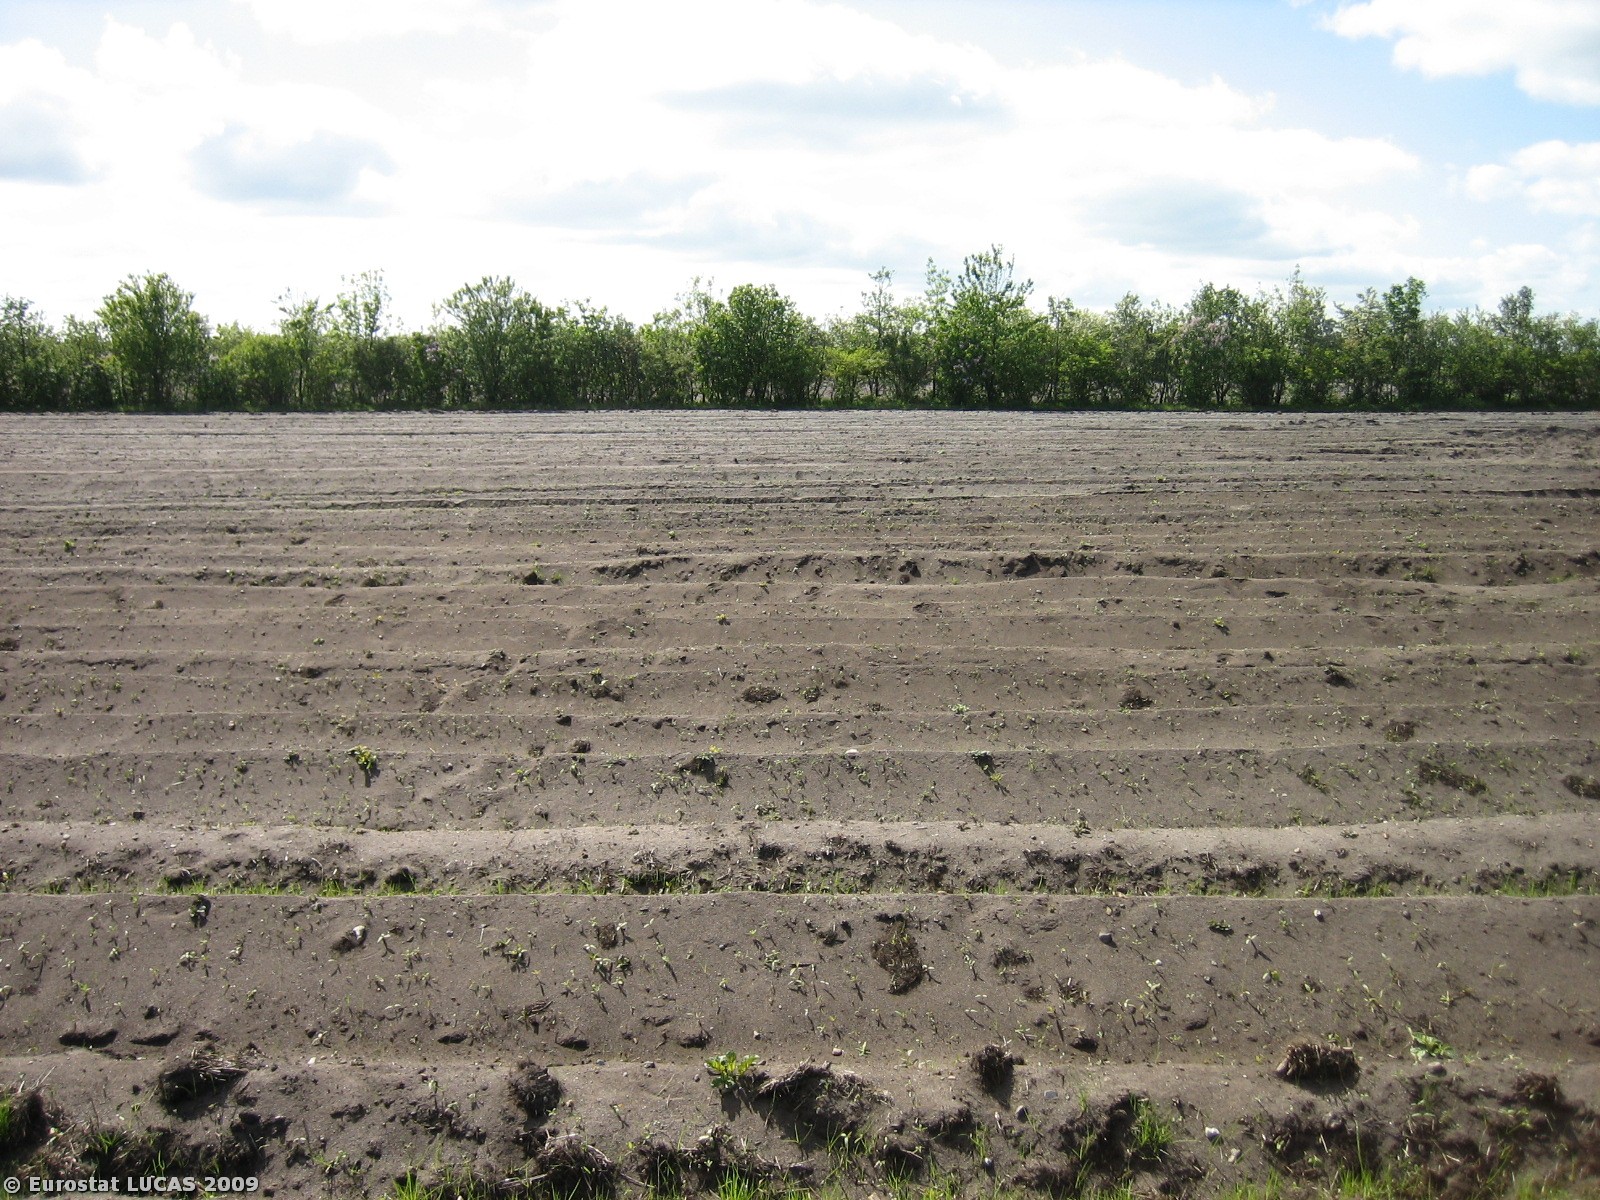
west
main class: Cropland
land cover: Potatoes
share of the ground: < 10 %
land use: Agriculture (excluding fallow land and kitchen gardens)
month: May
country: DK
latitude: 56.0040
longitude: 8.9908
